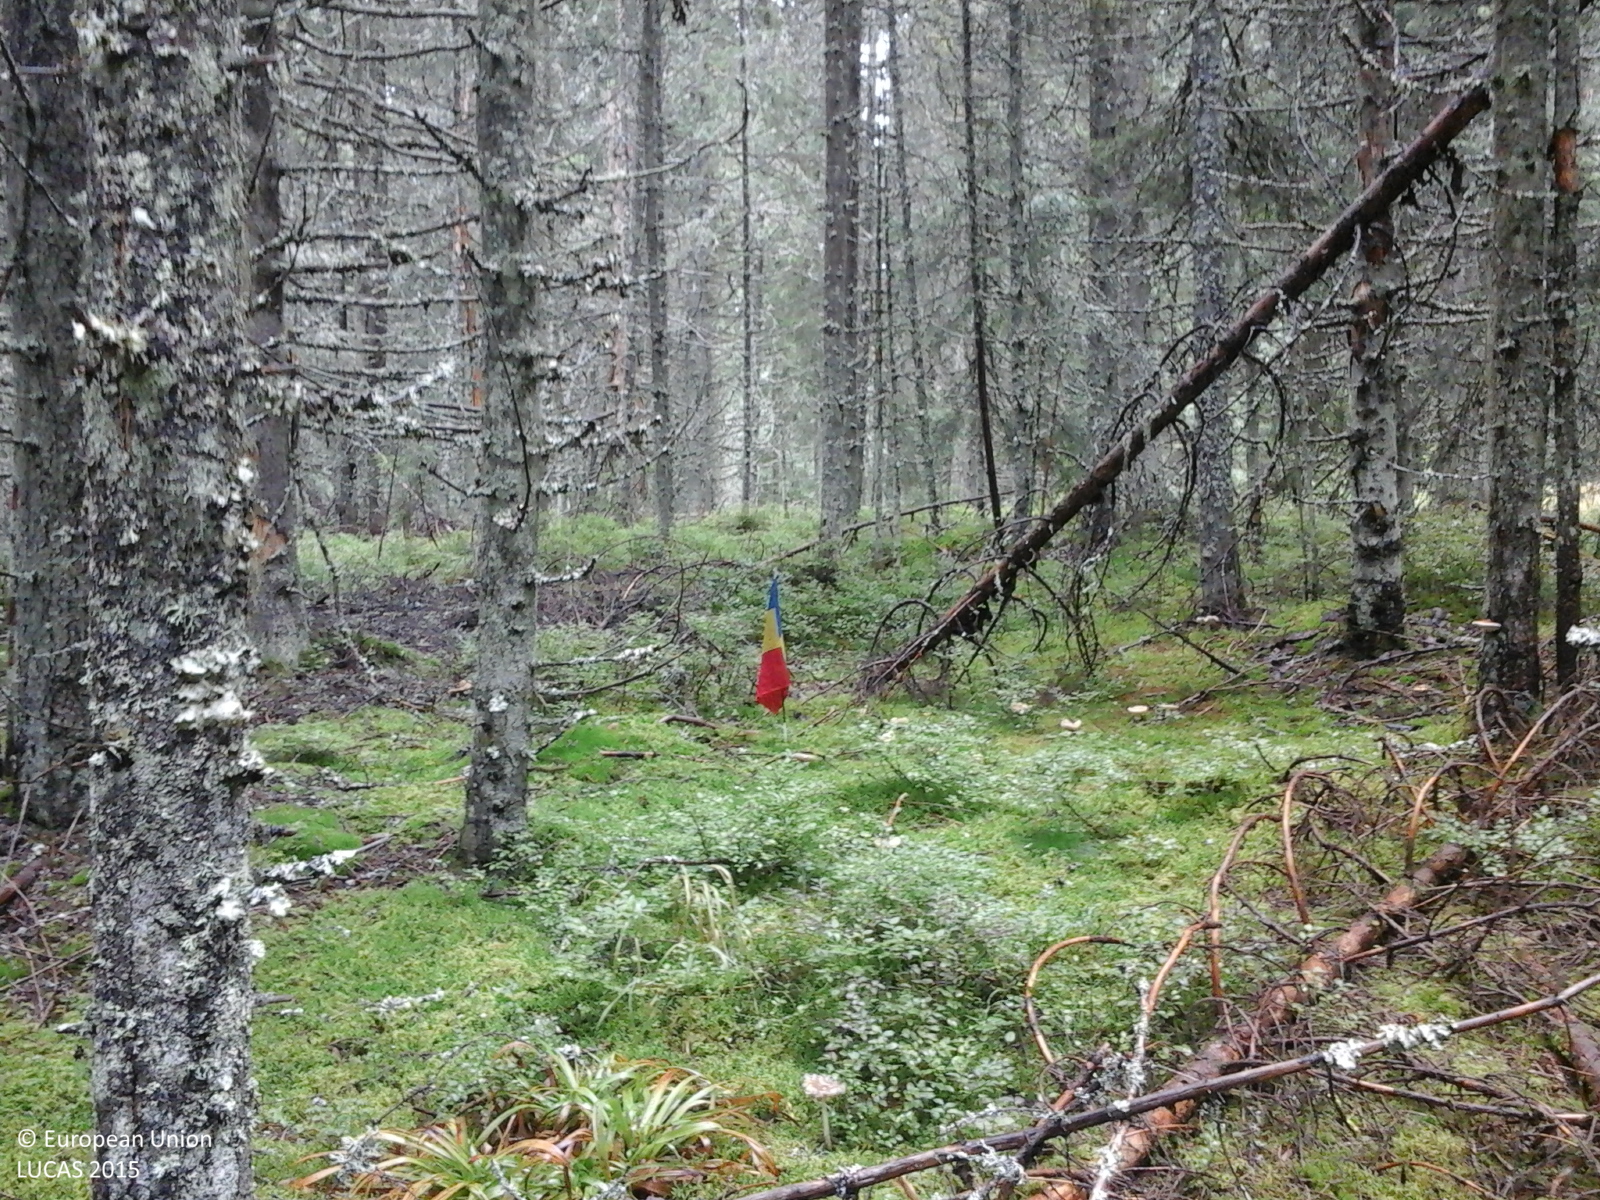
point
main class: Woodland
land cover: Spruce dominated coniferous woodland
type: alpine coniferous forest
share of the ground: > 75 %
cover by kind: coniferous forest trees 90 %, herbaceous plants 10 %
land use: Forestry
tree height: > 5 m
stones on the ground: 10 - 25 %
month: September
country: RO
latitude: 45.5924
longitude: 23.5607
